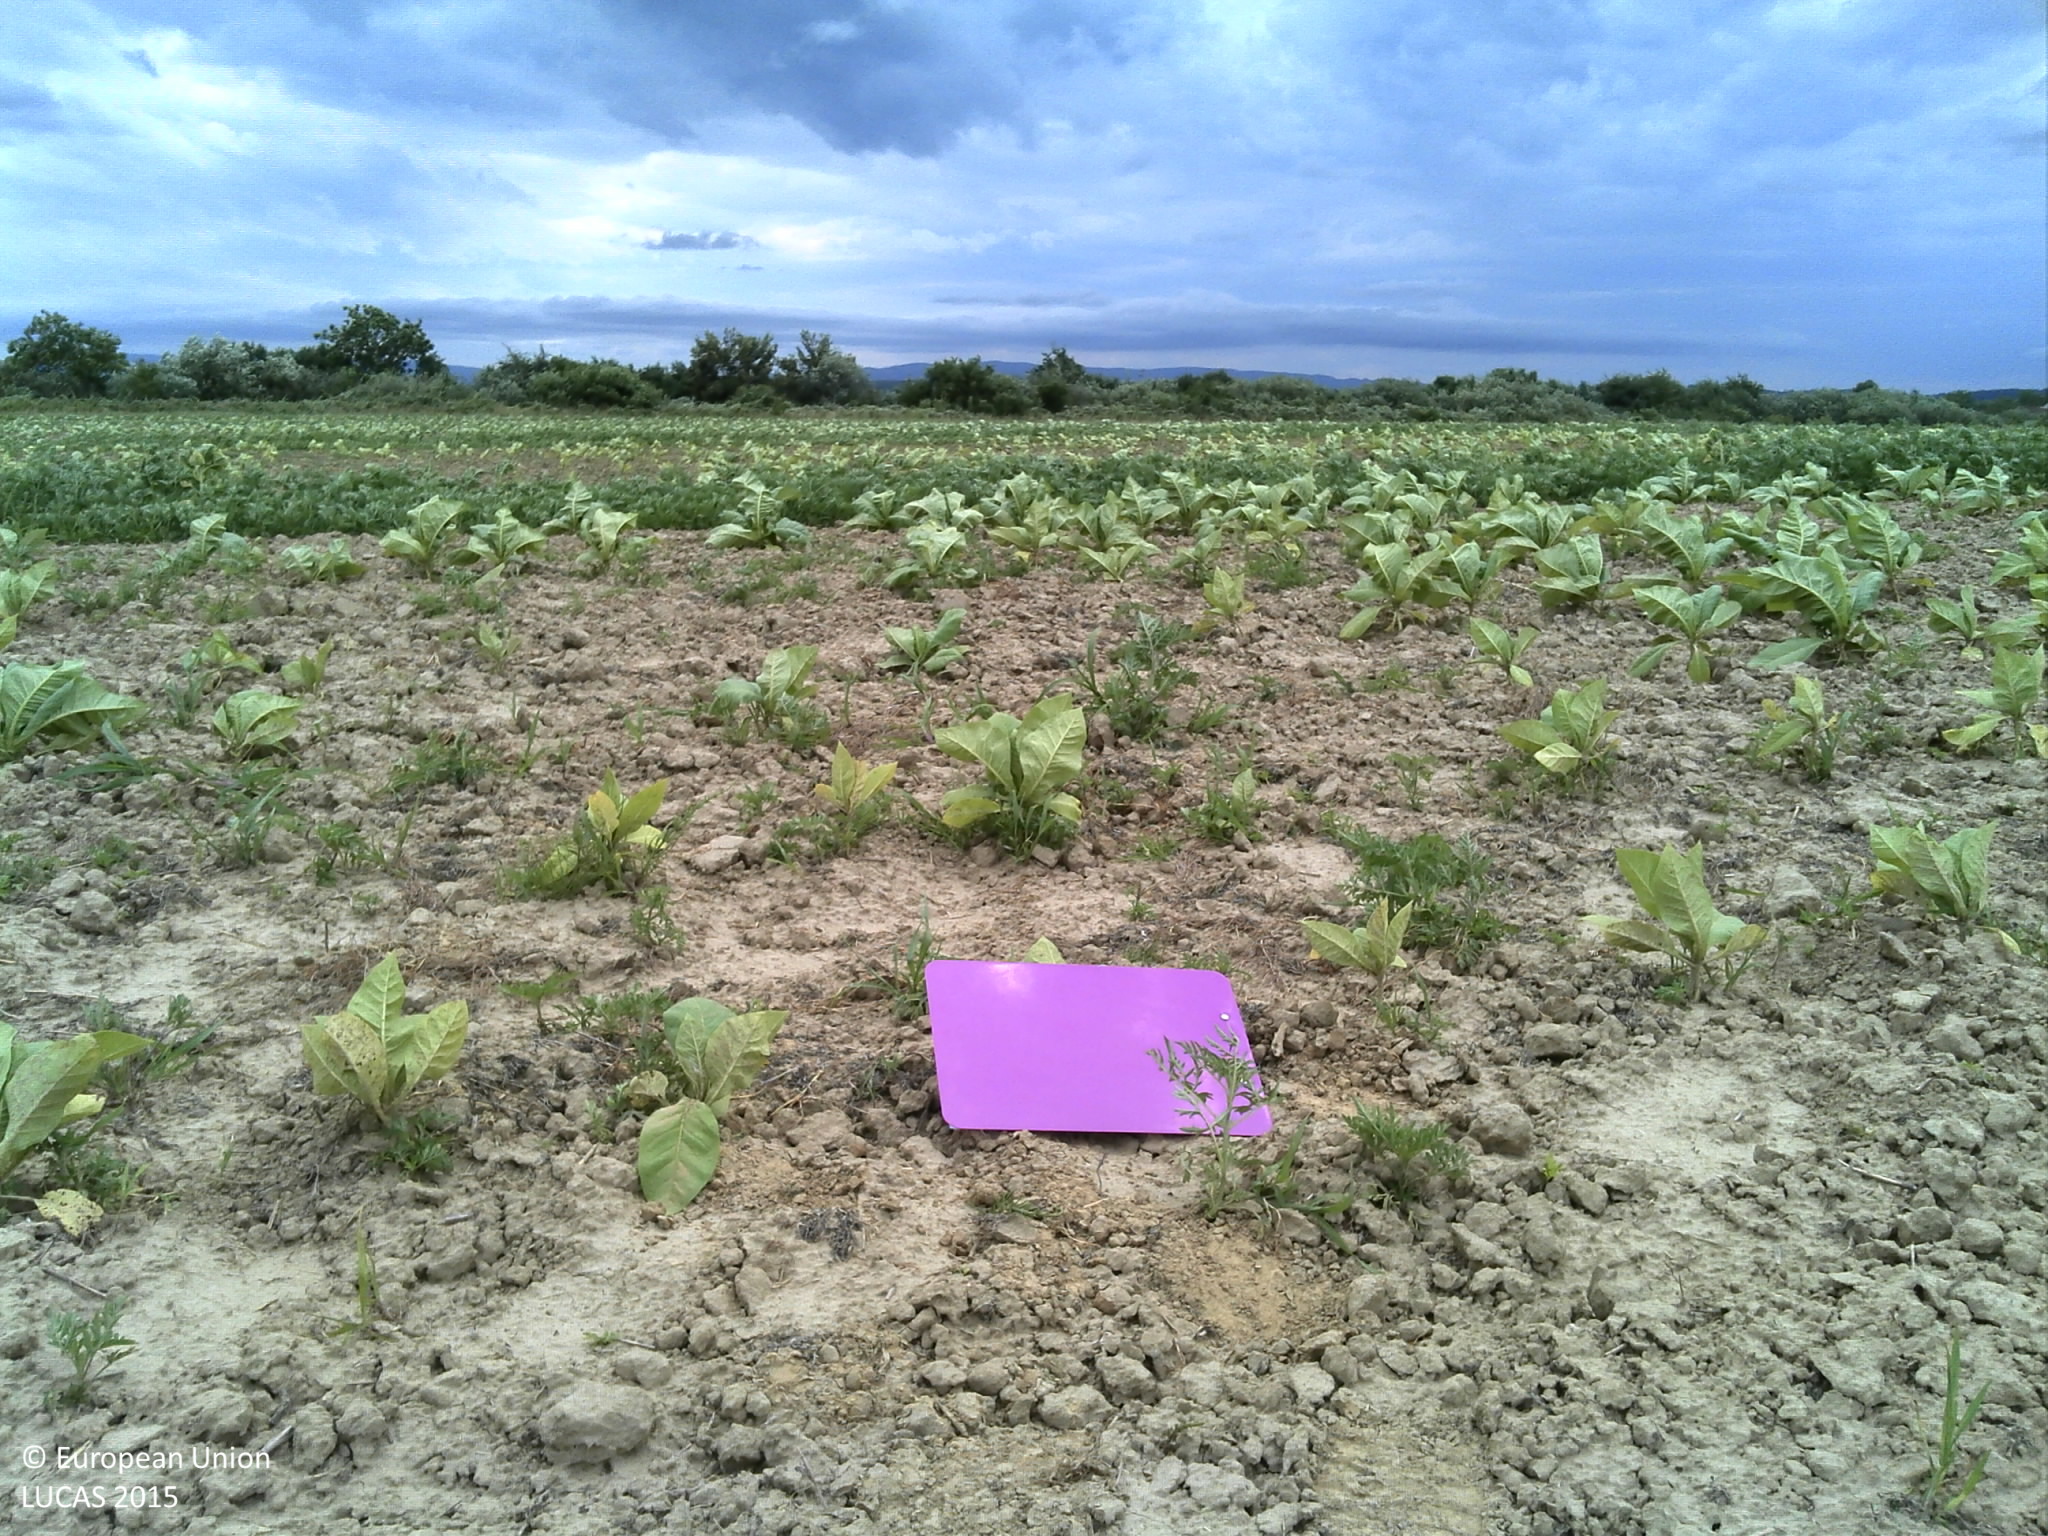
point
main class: Cropland
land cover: Tobacco
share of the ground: 10 - 25 %
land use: Agriculture (excluding fallow land and kitchen gardens)
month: June
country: HR
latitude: 45.8141
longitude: 17.5314
